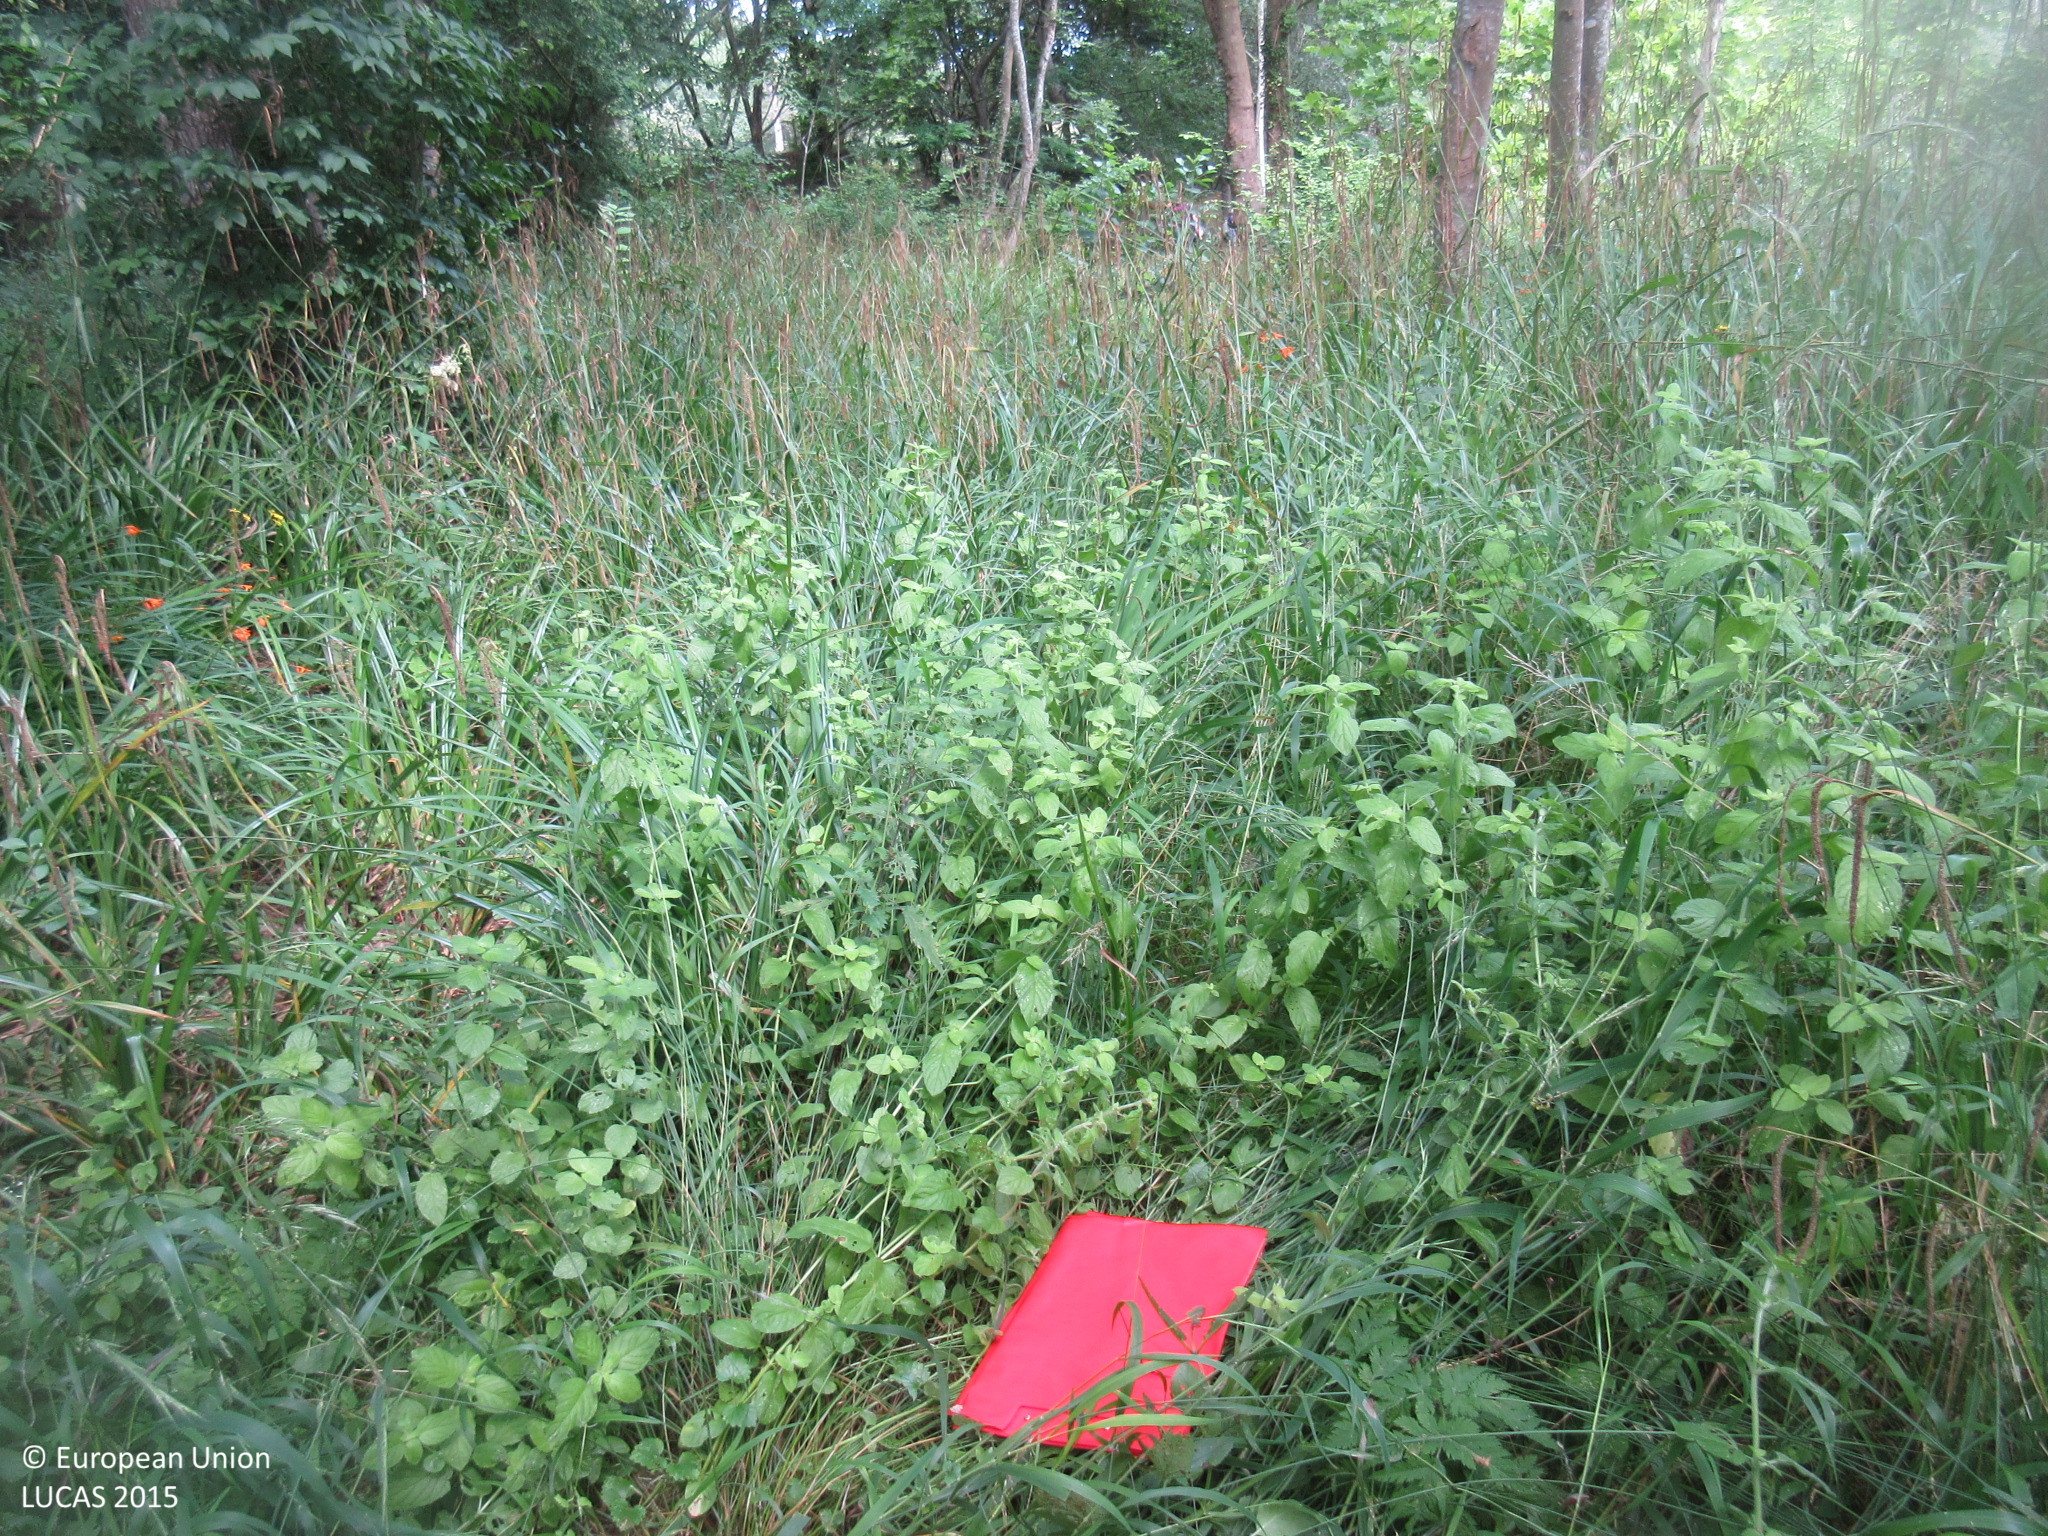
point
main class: Woodland
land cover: Broadleaved woodland
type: floodplain forest
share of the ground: > 75 %
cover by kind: broadleaved forest trees 90 %, shrubs 10 %
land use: Semi-natural and natural areas not in use
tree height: > 5 m
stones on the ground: < 10 %
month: July
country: ES
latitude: 43.3115
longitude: -4.4720
